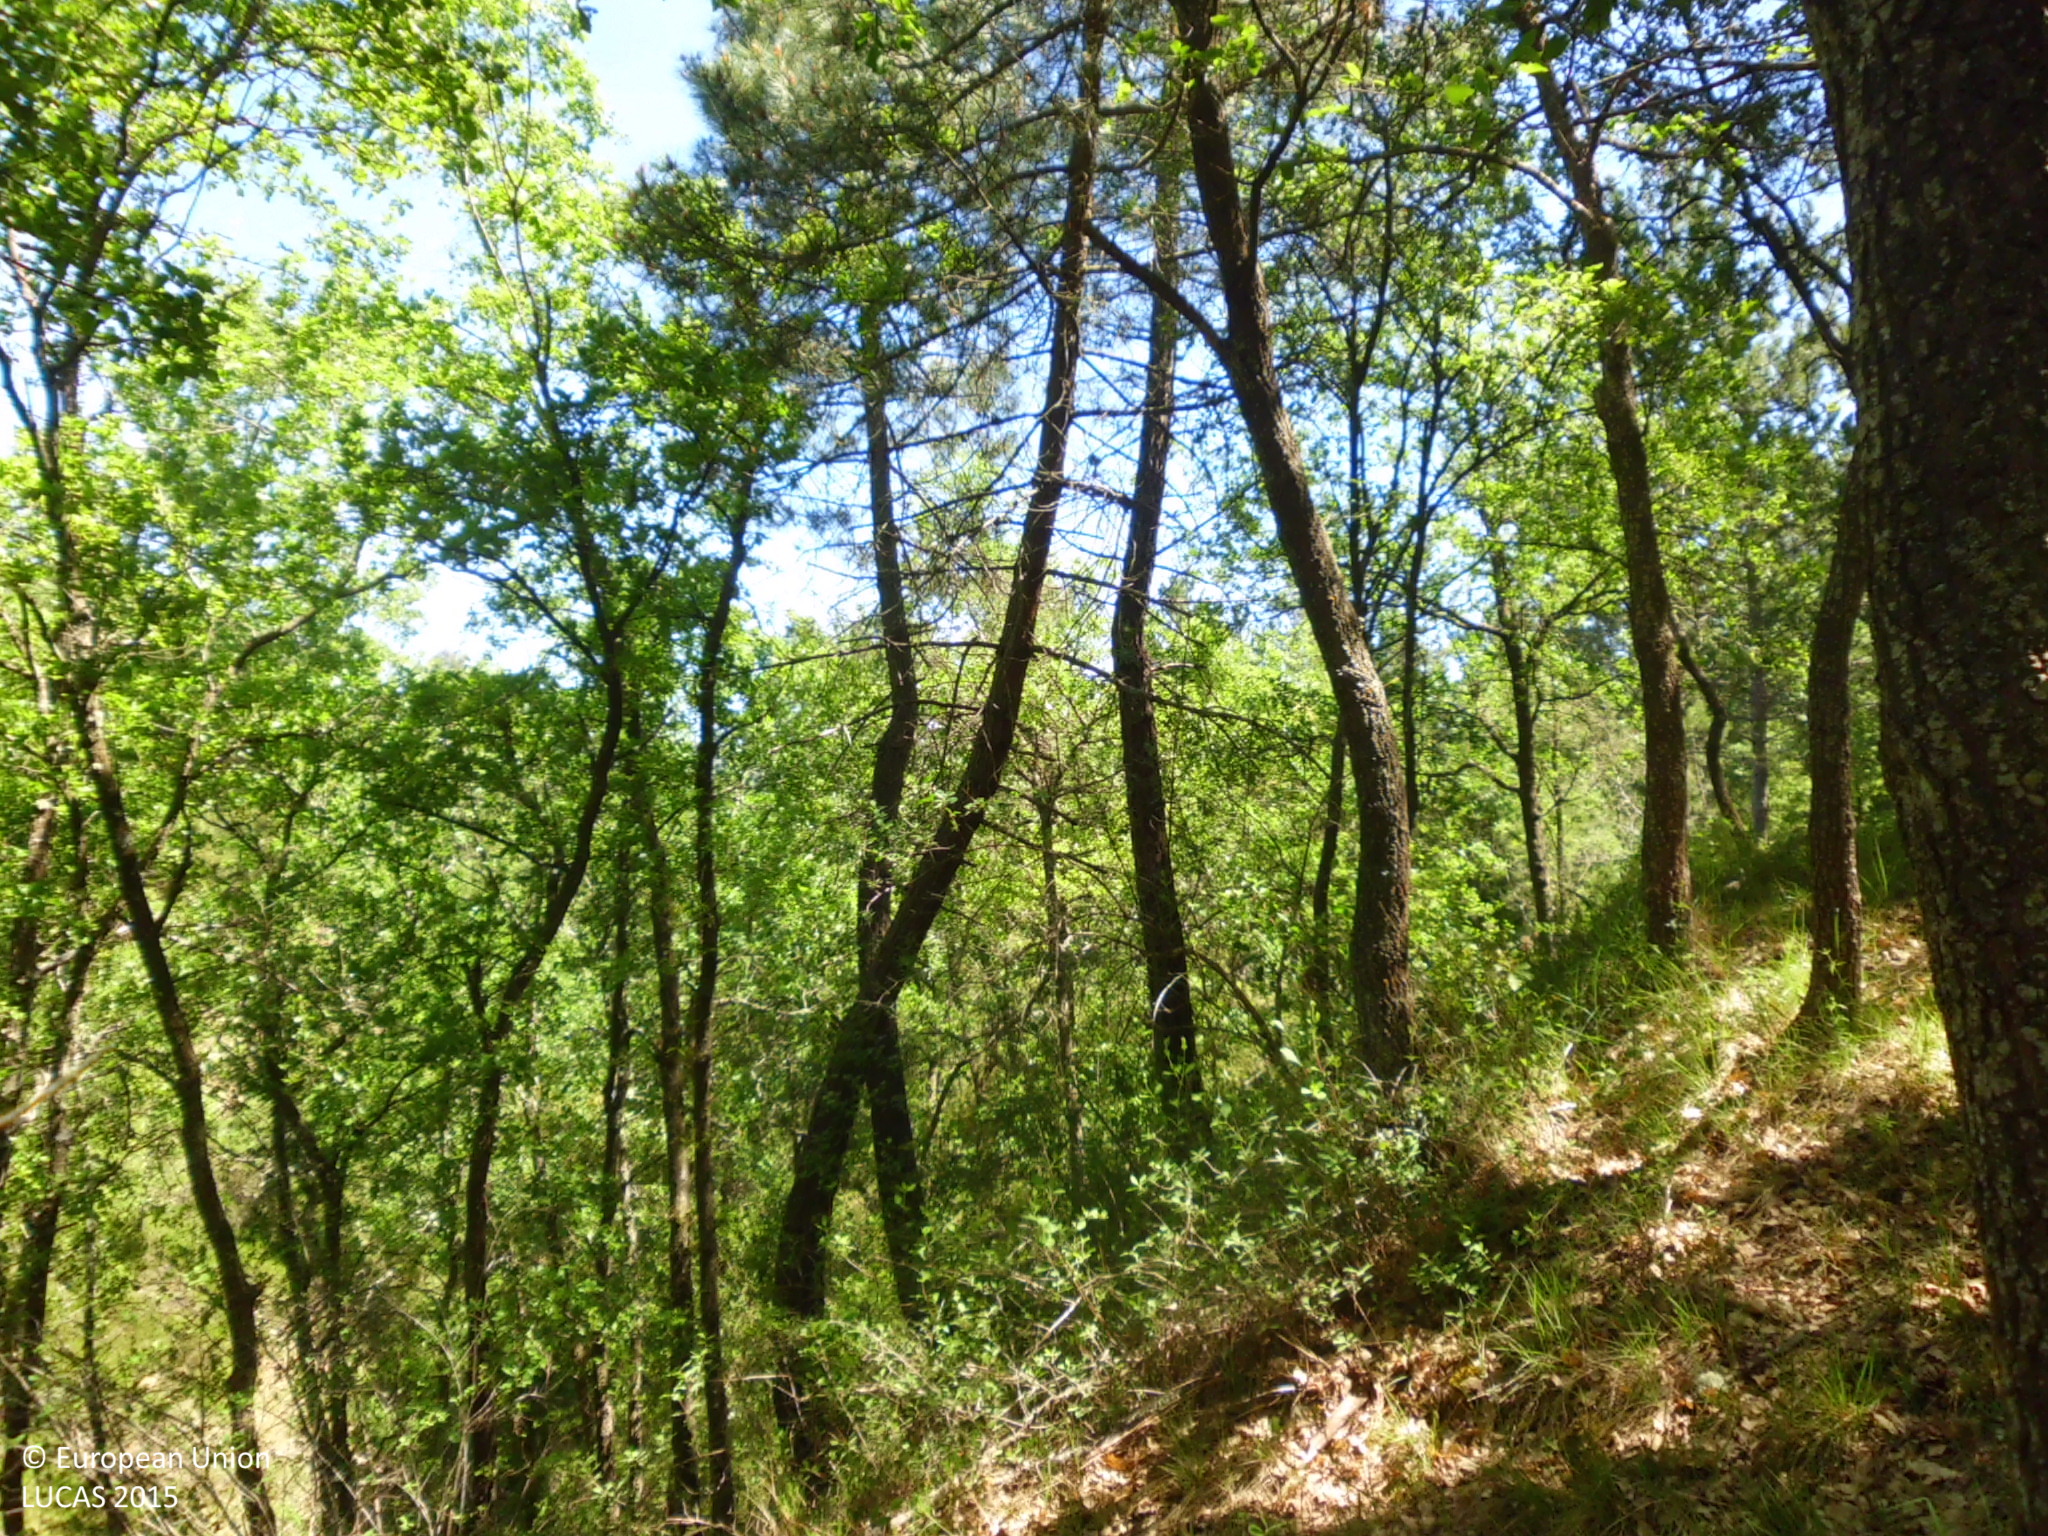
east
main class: Woodland
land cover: Pine dominated mixed woodland
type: coniferous forest of the mediterranean region
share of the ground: 50 - 75 %
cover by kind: coniferous forest trees 45 %, broadleaved forest trees 25 %, shrubs 20 %, herbaceous plants 10 %
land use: Semi-natural and natural areas not in use
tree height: > 5 m
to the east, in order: Pine dominated mixed woodland
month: May
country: ES
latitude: 42.7203
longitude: -3.4569
